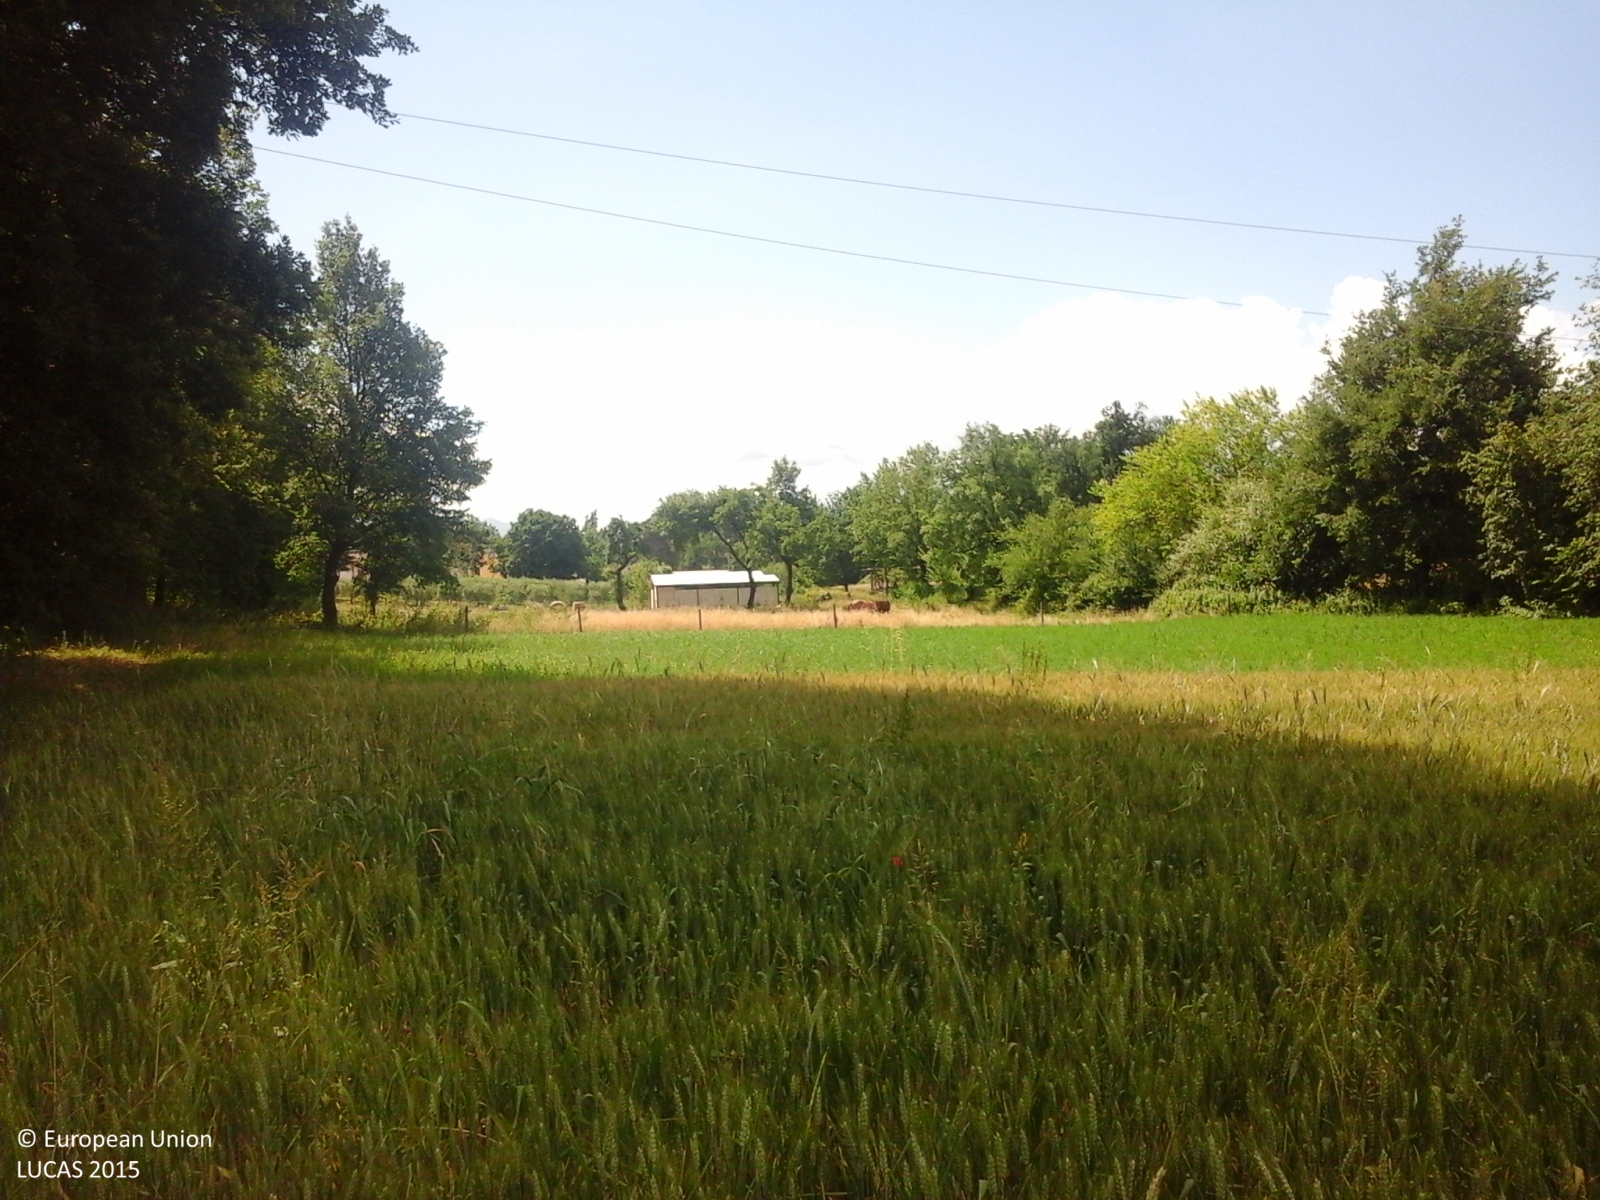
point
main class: Cropland
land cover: Durum wheat
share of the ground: > 75 %
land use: Agriculture (excluding fallow land and kitchen gardens)
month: May
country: IT
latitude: 41.6760
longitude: 13.3628
